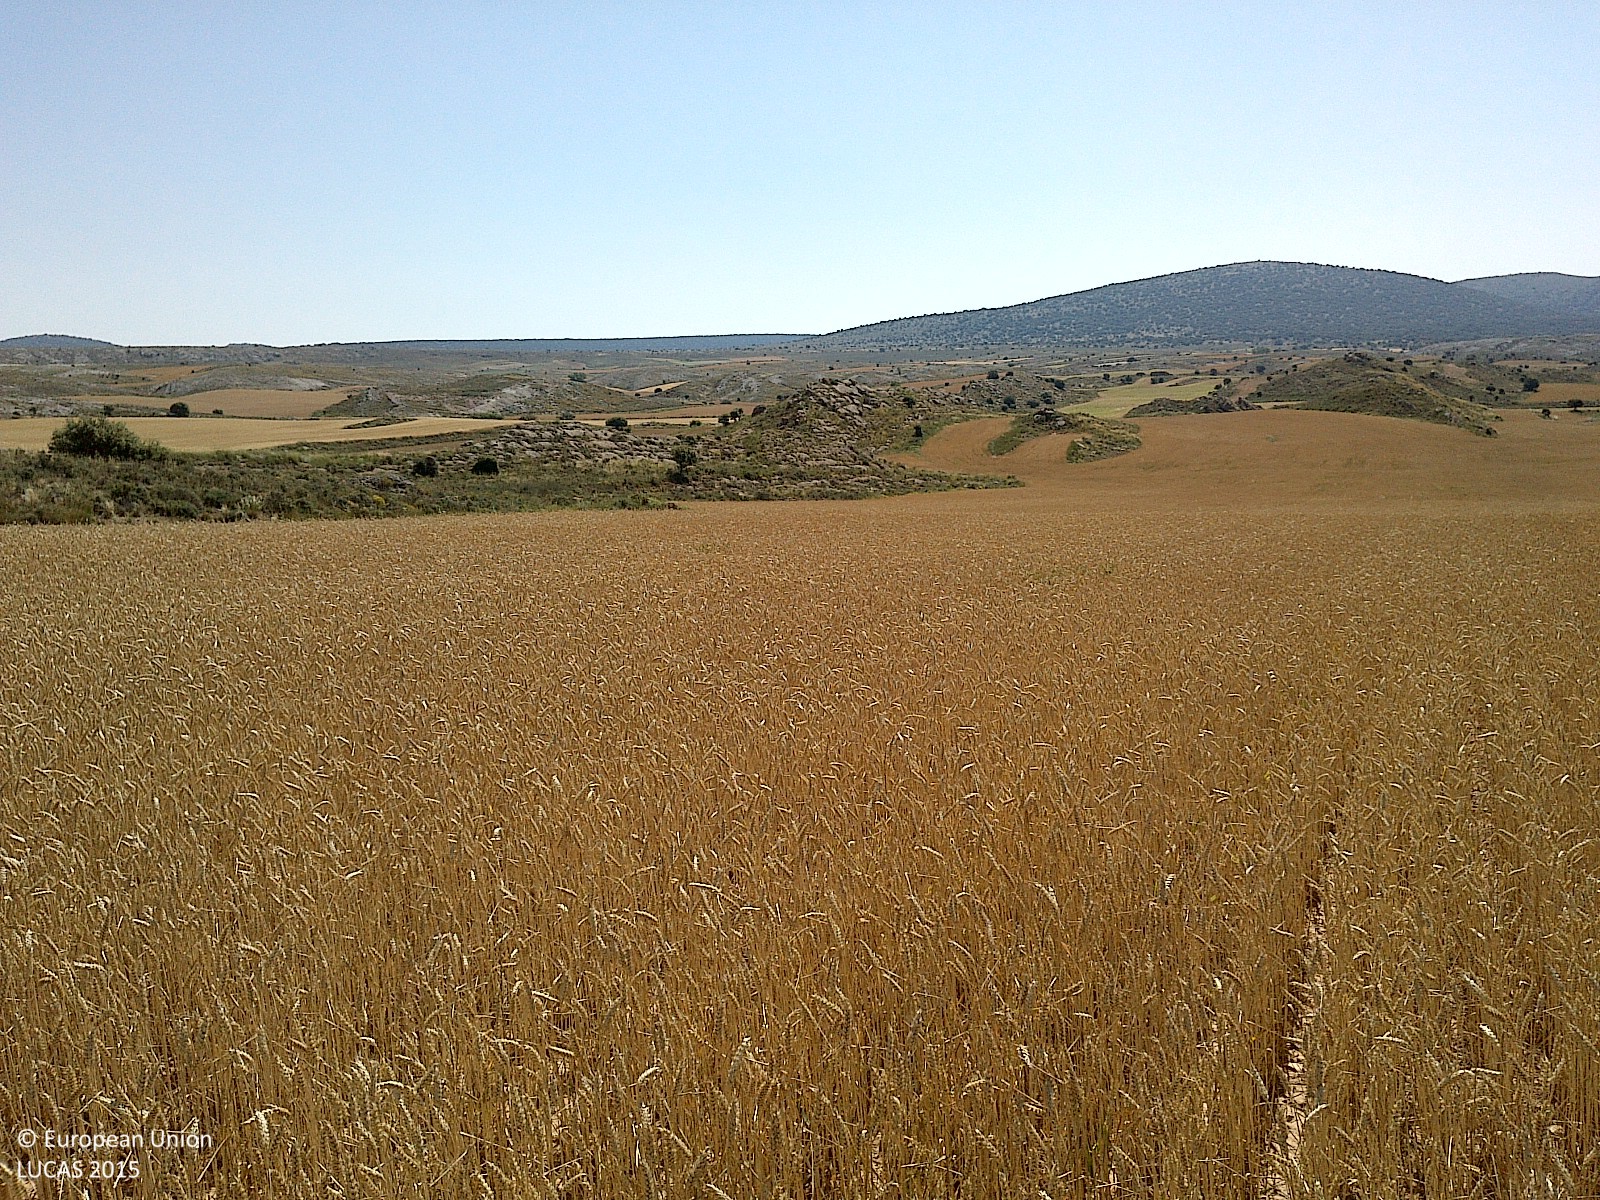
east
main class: Cropland
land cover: Common wheat
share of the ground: > 75 %
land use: Agriculture (excluding fallow land and kitchen gardens)
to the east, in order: Common wheat; Shrubland without tree cover; Rock outcrops; Shrubland without tree cover; Rocks and stones; Grassland without tree/shrub cover; Common wheat; Grassland without tree/shrub cover
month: July
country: ES
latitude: 41.5572
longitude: -2.1301
